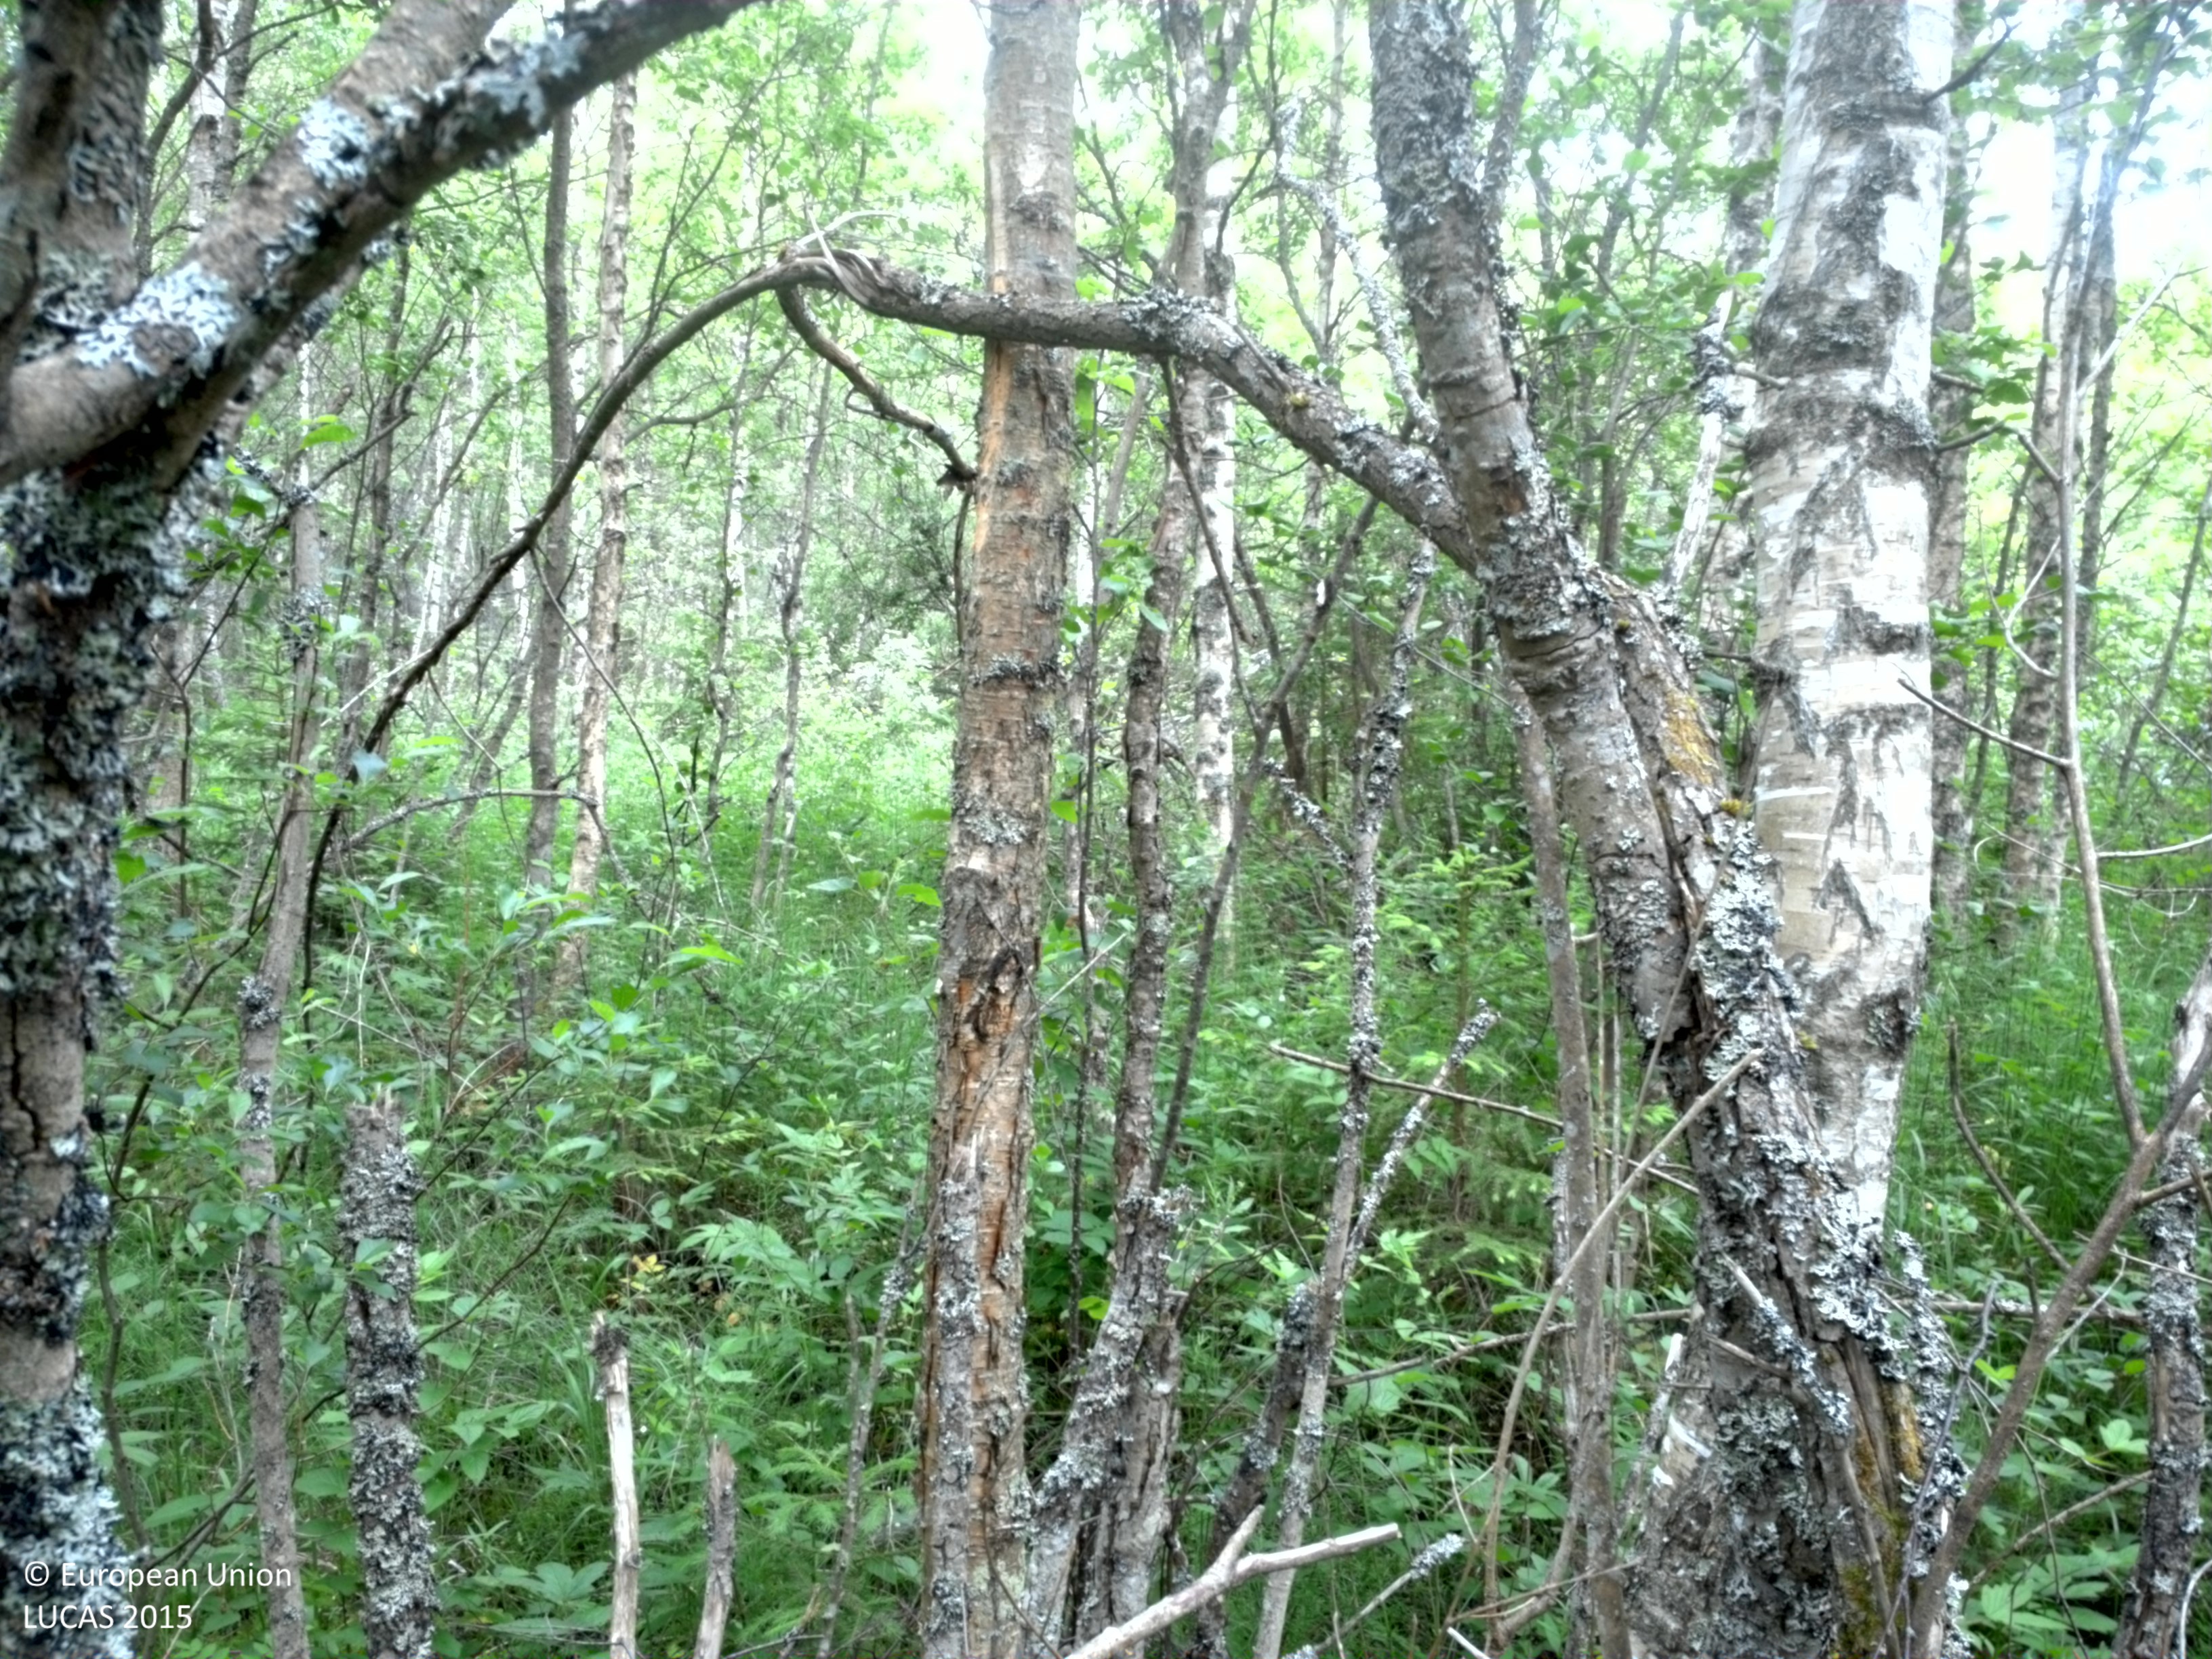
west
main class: Woodland
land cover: Broadleaved woodland
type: hemiboreal forest and nemoral coniferous forest and mixed broadleaved-coniferous forest
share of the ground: > 75 %
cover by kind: broadleaved forest trees 90 %, herbaceous plants 10 %
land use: Forestry
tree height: > 5 m
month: July
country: SE
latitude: 59.9547
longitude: 16.9571
